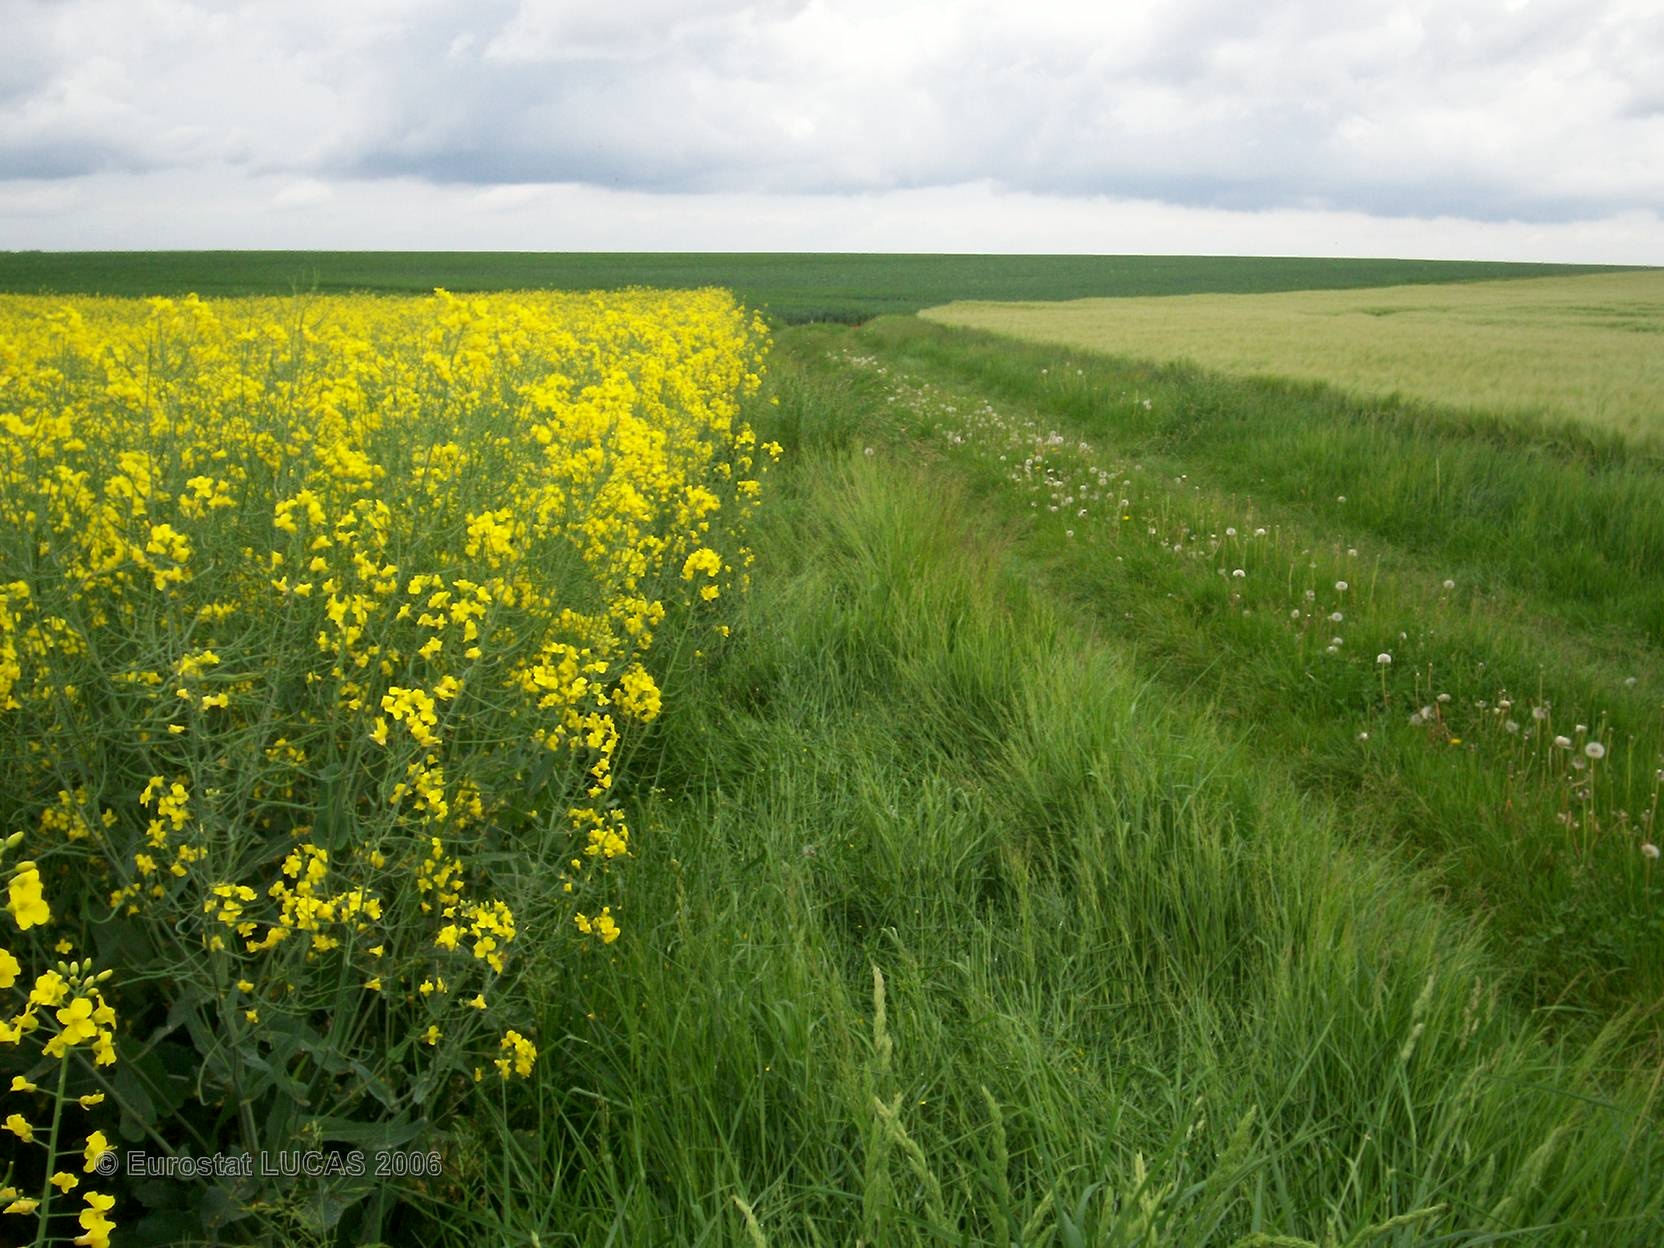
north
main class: Cropland
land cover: Rape and turnip rape
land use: Agriculture (excluding fallow land and kitchen gardens)
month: May
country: FR
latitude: 48.1943
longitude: 4.4954
